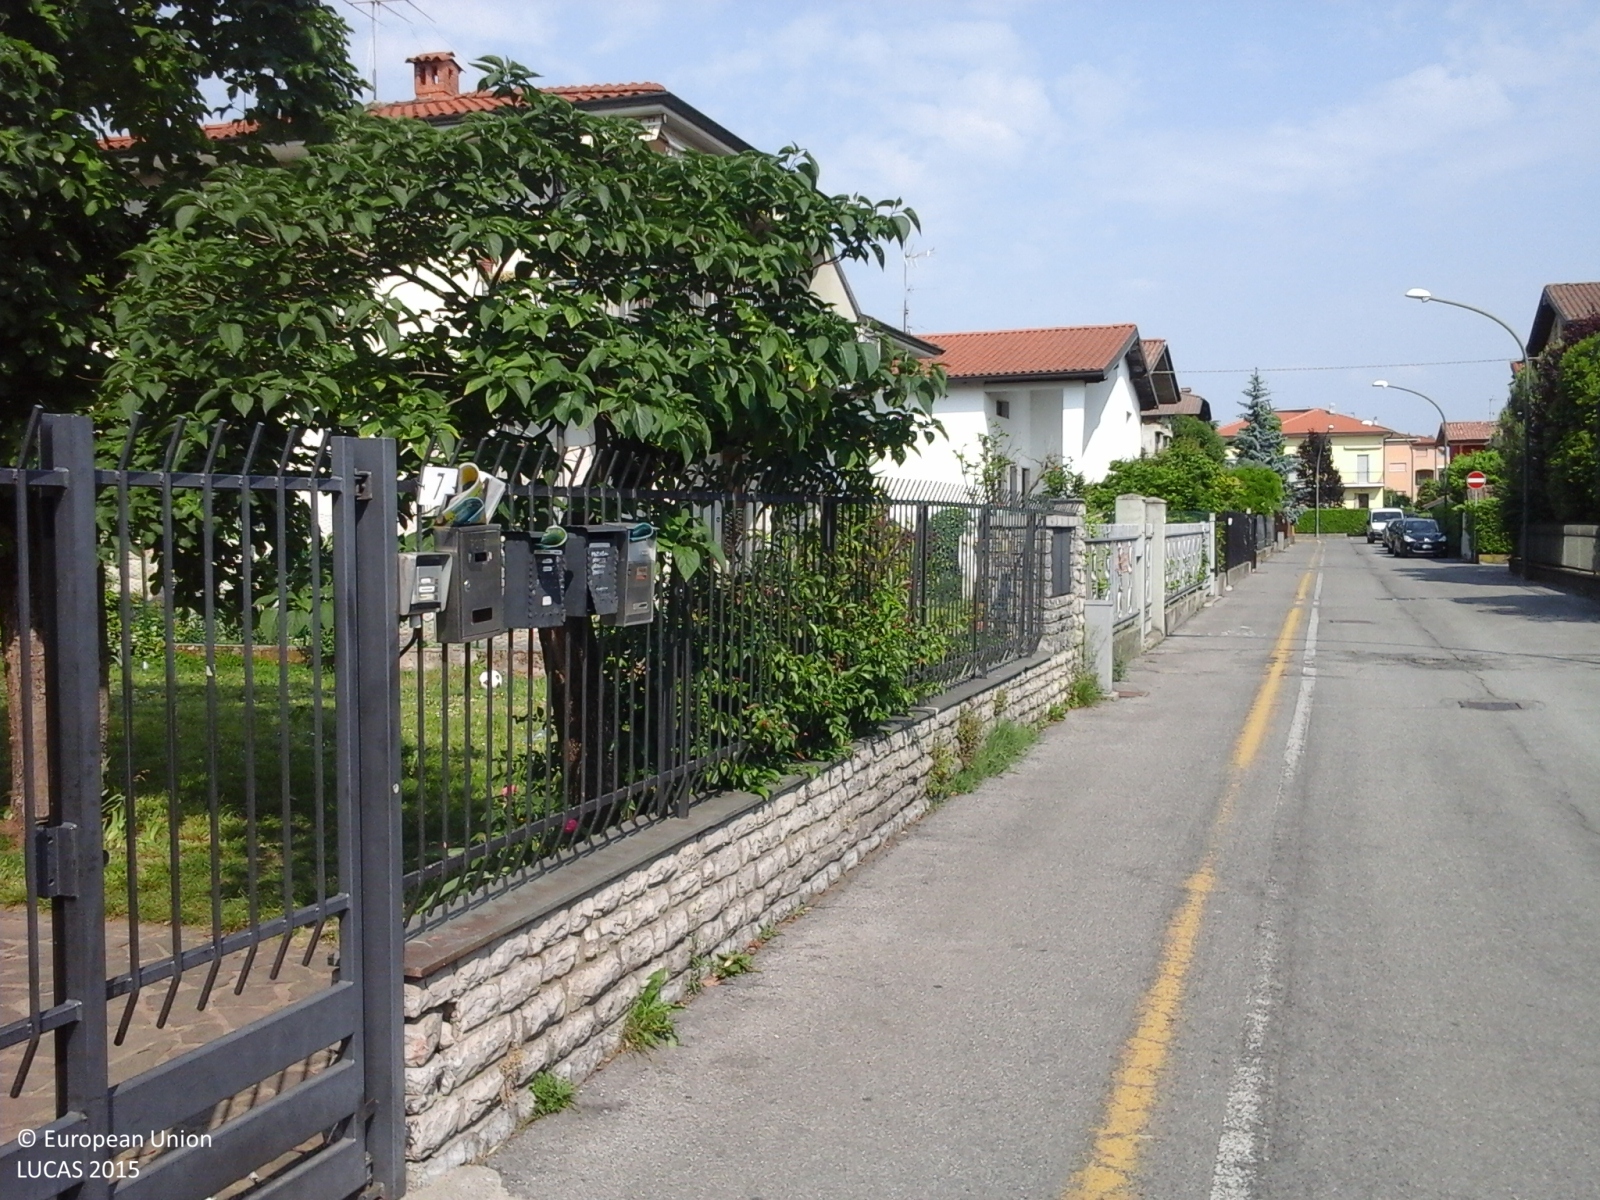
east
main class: Grassland
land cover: Grassland with sparse tree/shrub cover
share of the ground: > 75 %
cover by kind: herbaceous plants 90 %, broadleaved forest trees 5 %, shrubs 5 %
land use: Residential
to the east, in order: Grassland with sparse tree/shrub cover; Artificial constructions in urban areas
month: May
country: IT
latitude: 45.6480
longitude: 9.6541
